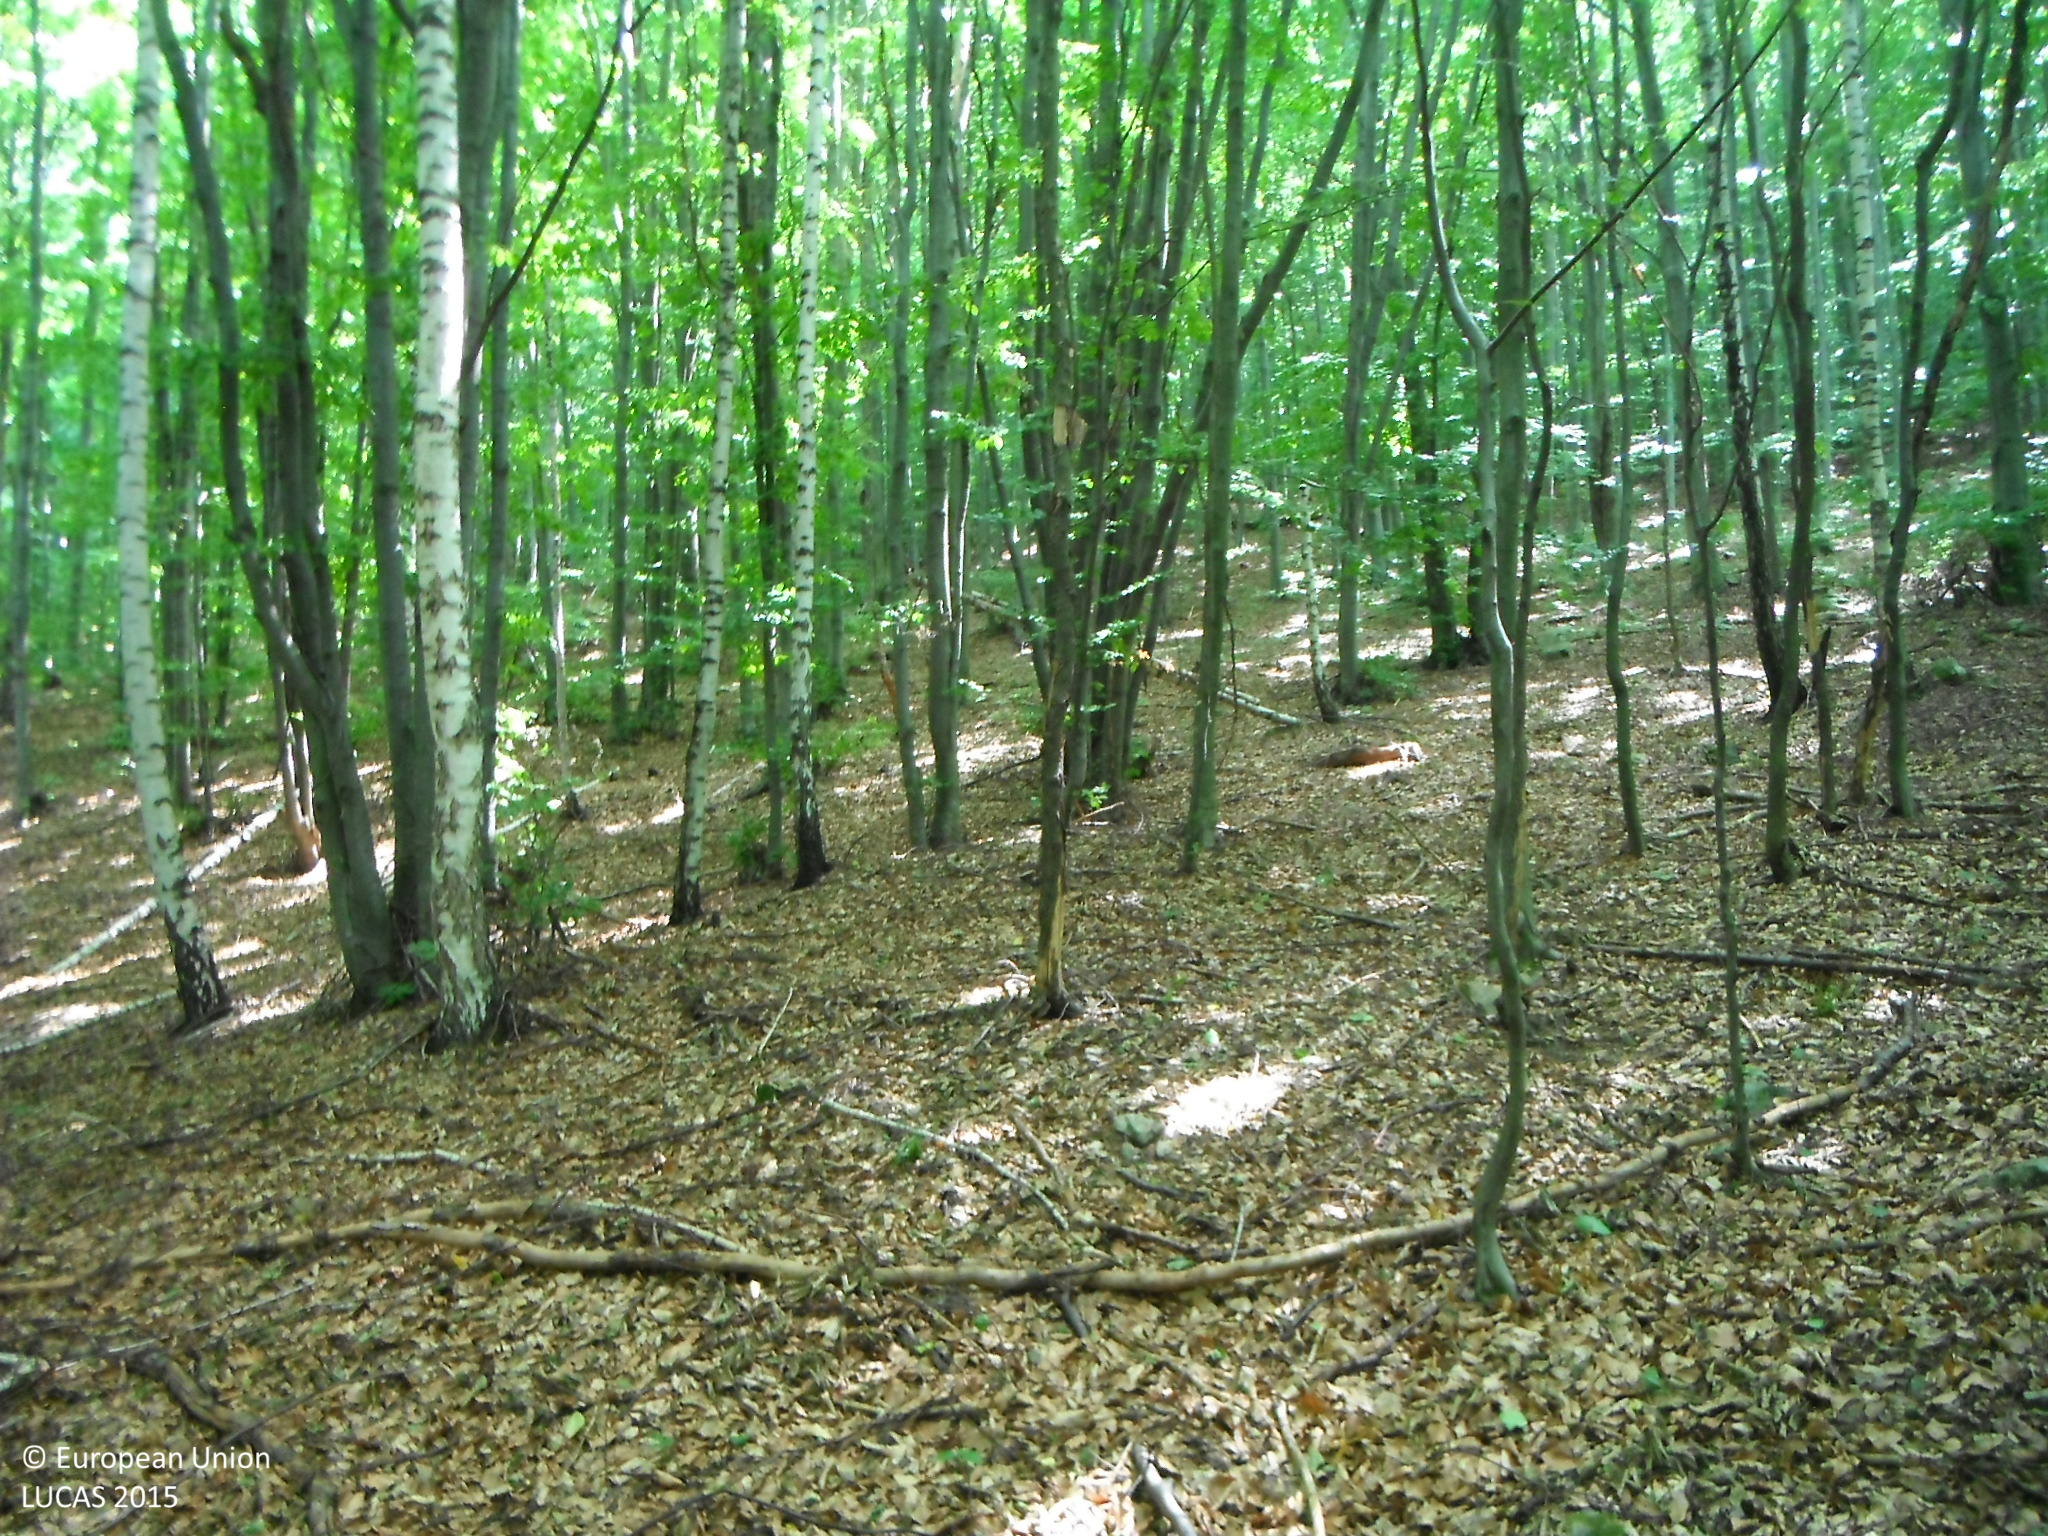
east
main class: Woodland
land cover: Broadleaved woodland
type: beech forest
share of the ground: > 75 %
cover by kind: broadleaved forest trees 100 %
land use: Forestry
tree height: > 5 m
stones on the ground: > 50 %
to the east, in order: Broadleaved woodland; Tracks; Broadleaved woodland; Tracks; Broadleaved woodland; Tracks; Broadleaved woodland
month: July
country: SK
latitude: 48.7394
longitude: 20.0798
